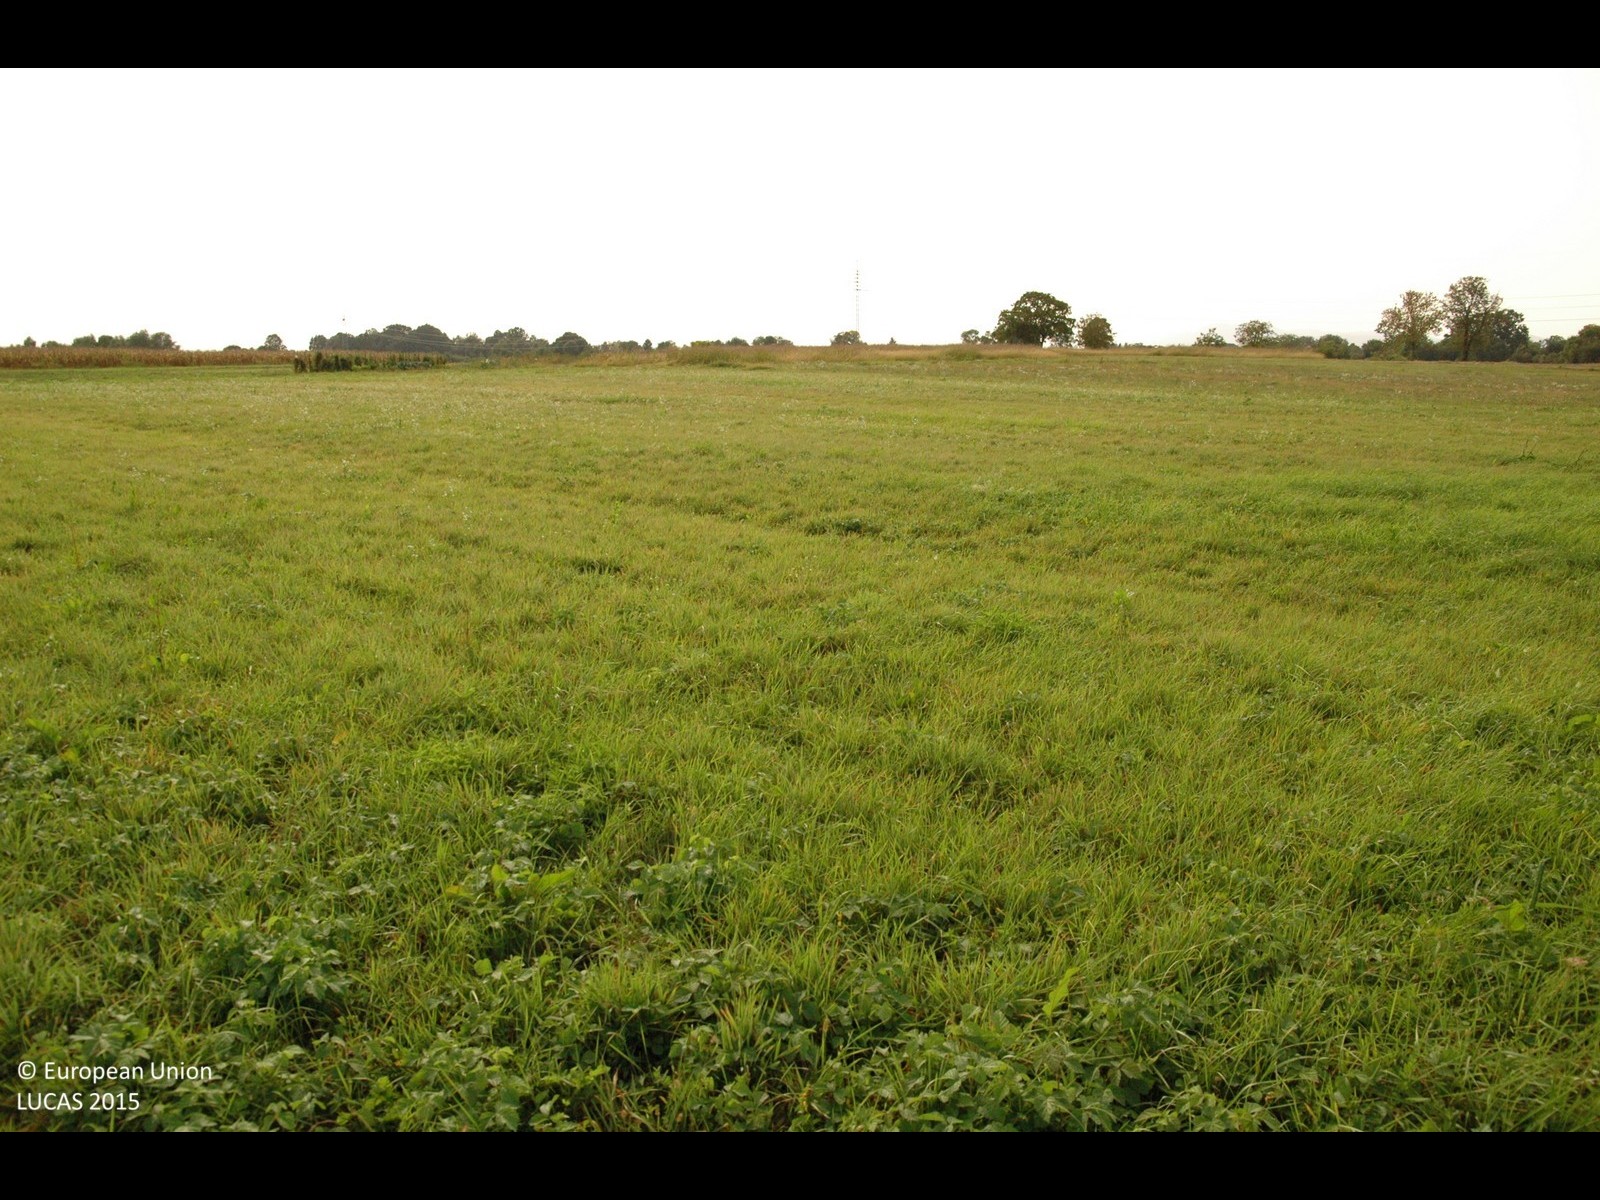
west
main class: Grassland
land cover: Grassland without tree/shrub cover
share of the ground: > 75 %
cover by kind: herbaceous plants 100 %
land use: Agriculture (excluding fallow land and kitchen gardens)
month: September
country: HR
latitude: 45.7176
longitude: 15.9201
